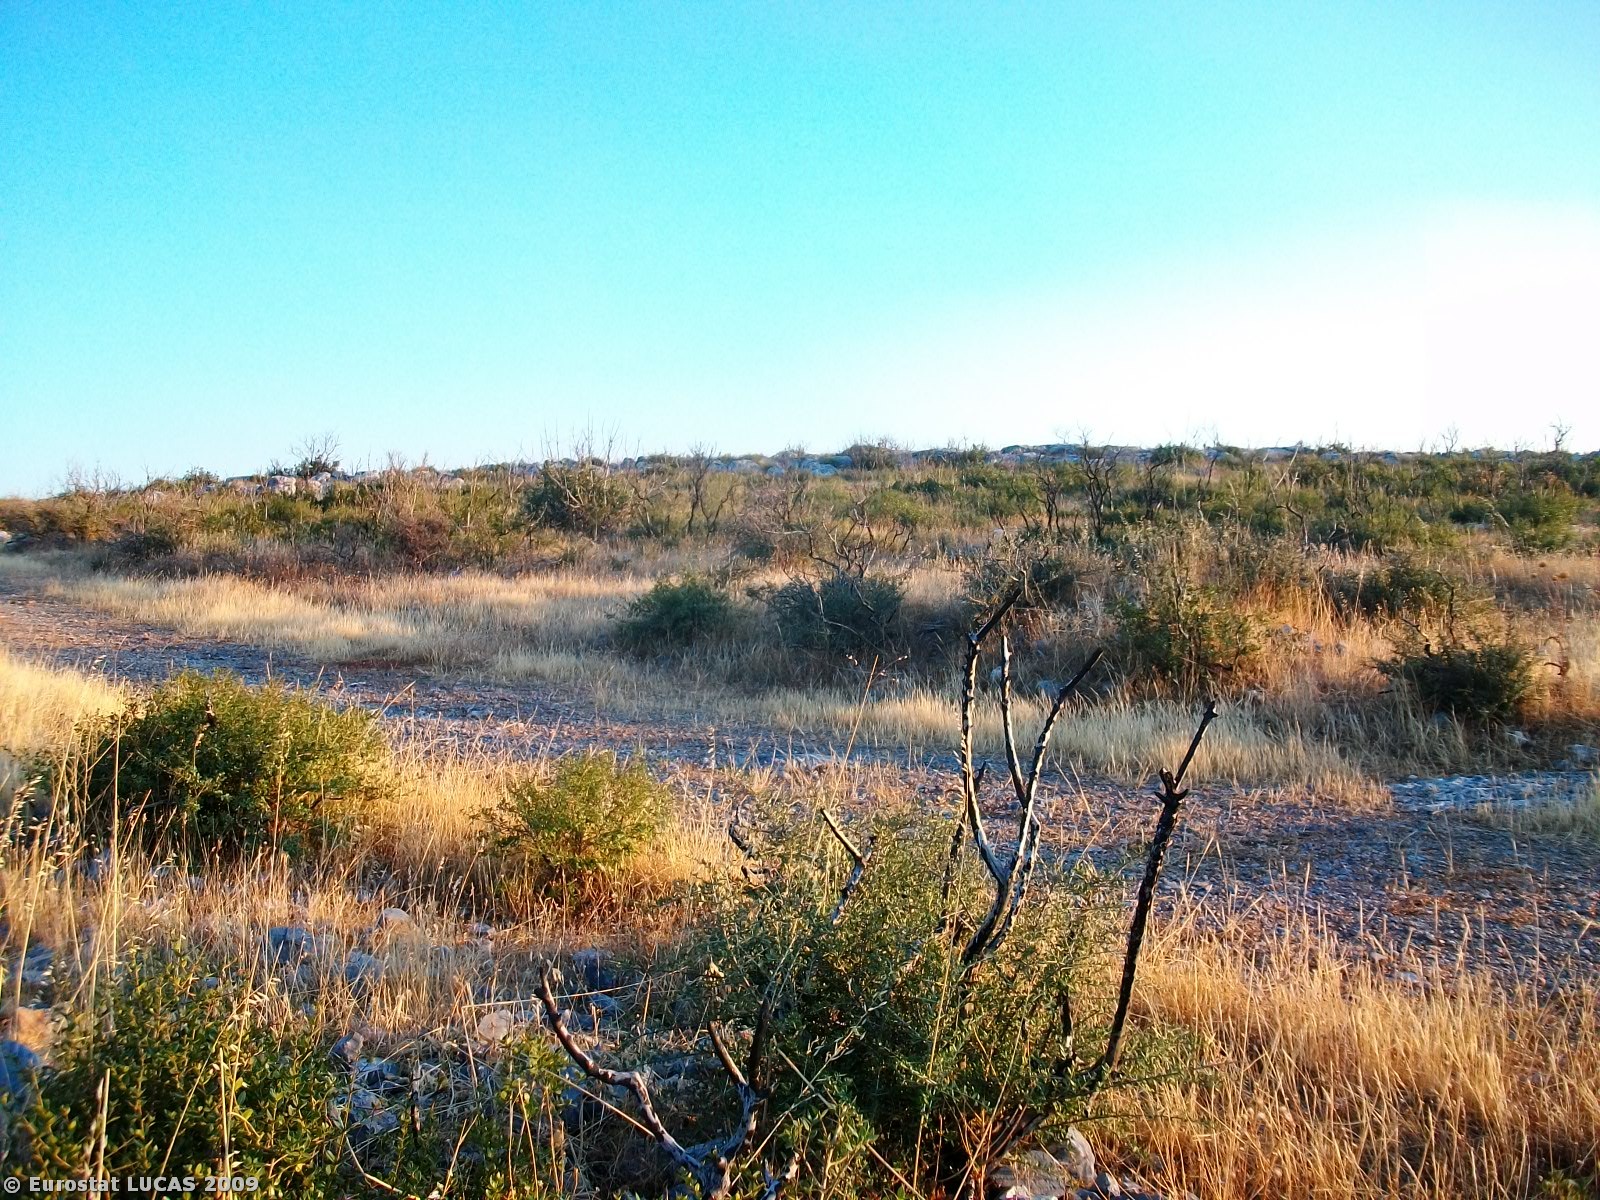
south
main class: Shrubland
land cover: Shrubland without tree cover
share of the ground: 50 - 75 %
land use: Unused
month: August
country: GR
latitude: 38.4681
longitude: 24.0081
